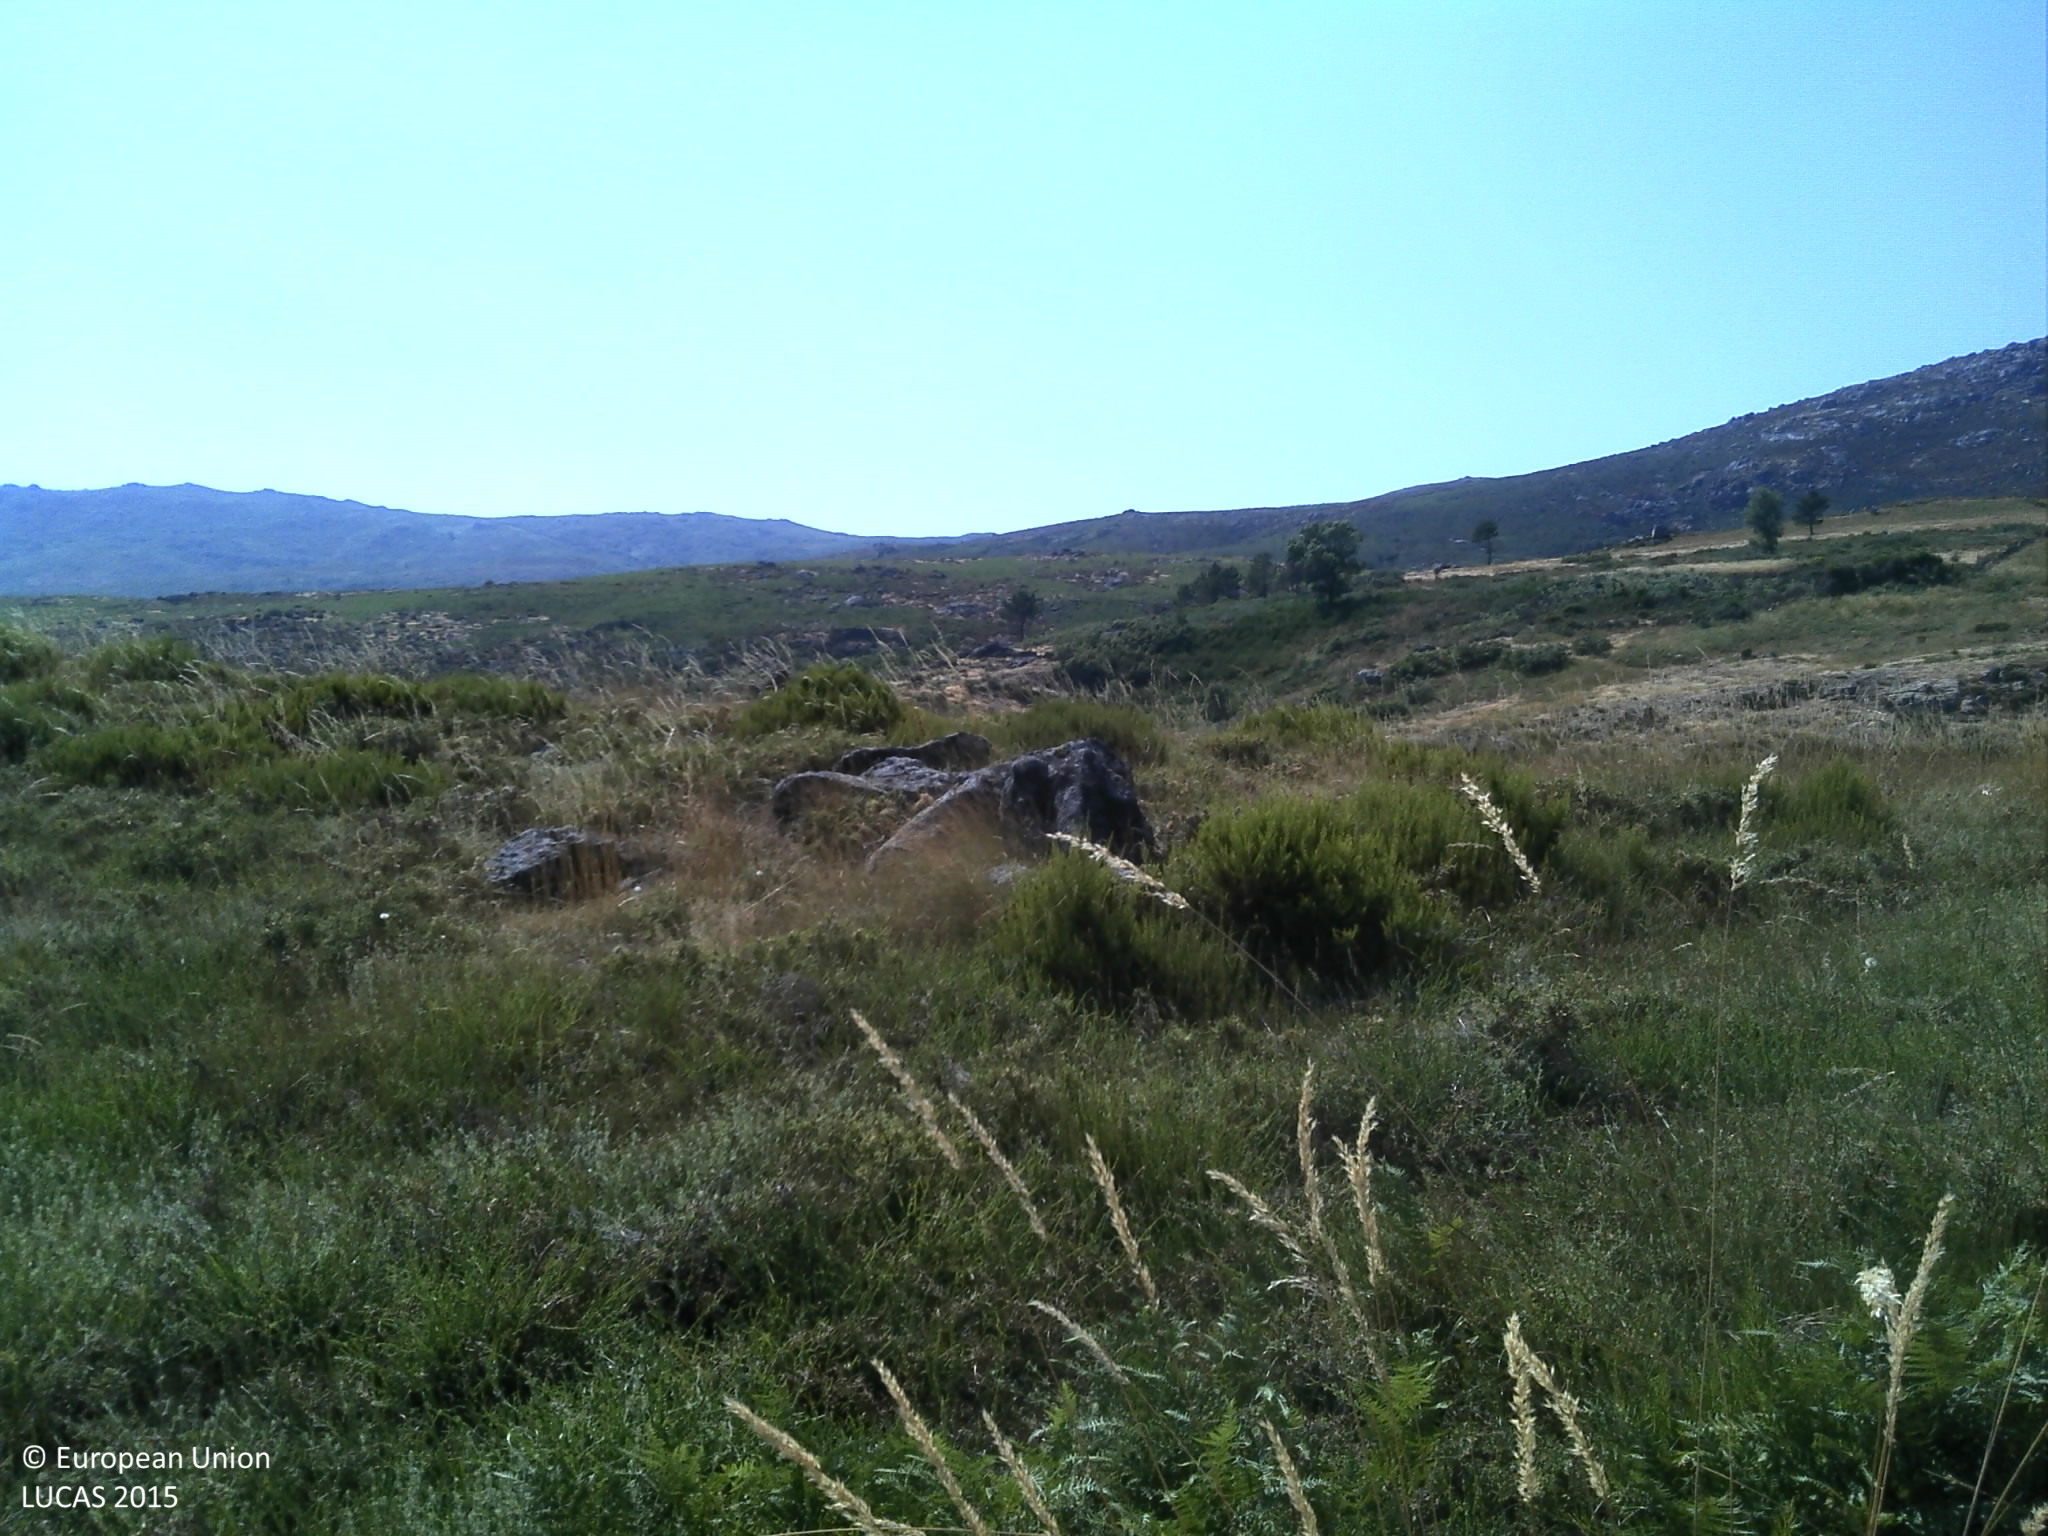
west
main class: Shrubland
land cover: Shrubland without tree cover
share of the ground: 50 - 75 %
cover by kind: shrubs 50 %, herbaceous plants 50 %
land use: Agriculture (excluding fallow land and kitchen gardens)
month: July
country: PT
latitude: 41.8493
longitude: -7.8350
